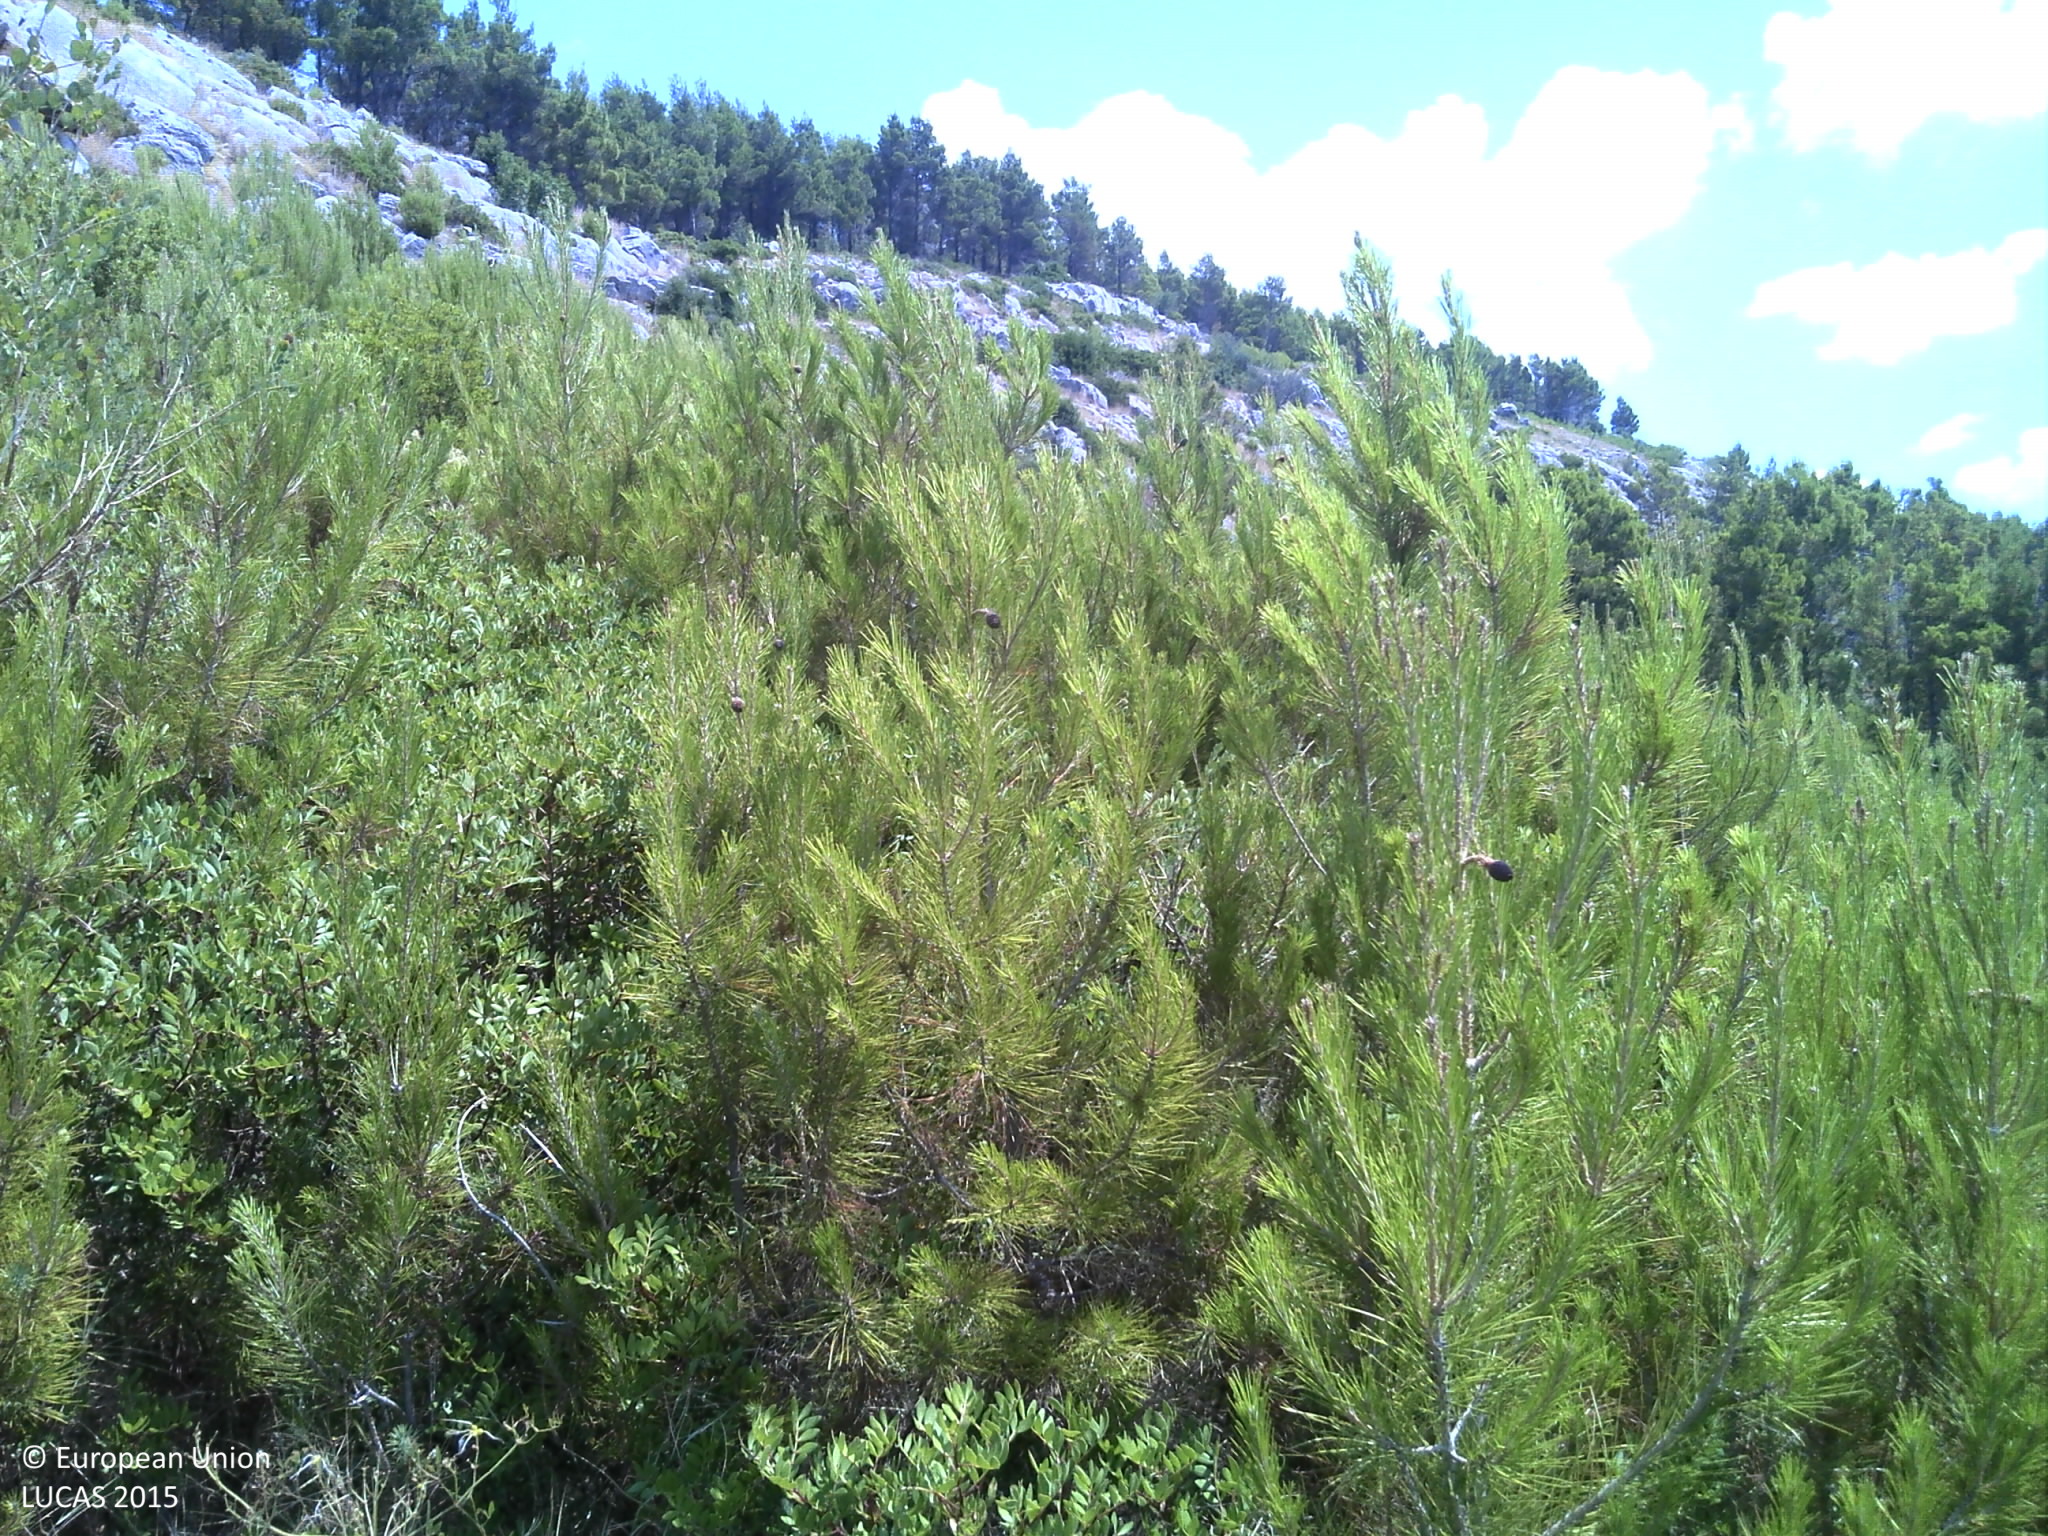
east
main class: Shrubland
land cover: Shrubland with sparse tree cover
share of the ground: > 75 %
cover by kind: shrubs 65 %, herbaceous plants 20 %, coniferous forest trees 5 %, consolidated bare surface 5 %, unconsolidated bare surface 5 %
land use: Semi-natural and natural areas not in use
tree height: < 5 m
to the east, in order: Shrubland with sparse tree cover; Grassland with sparse tree/shrub cover; Shrubland with sparse tree cover; Pine dominated coniferous woodland; Tracks; Grassland with sparse tree/shrub cover; Tracks; Pine dominated coniferous woodland
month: August
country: HR
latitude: 43.3366
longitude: 16.9845
